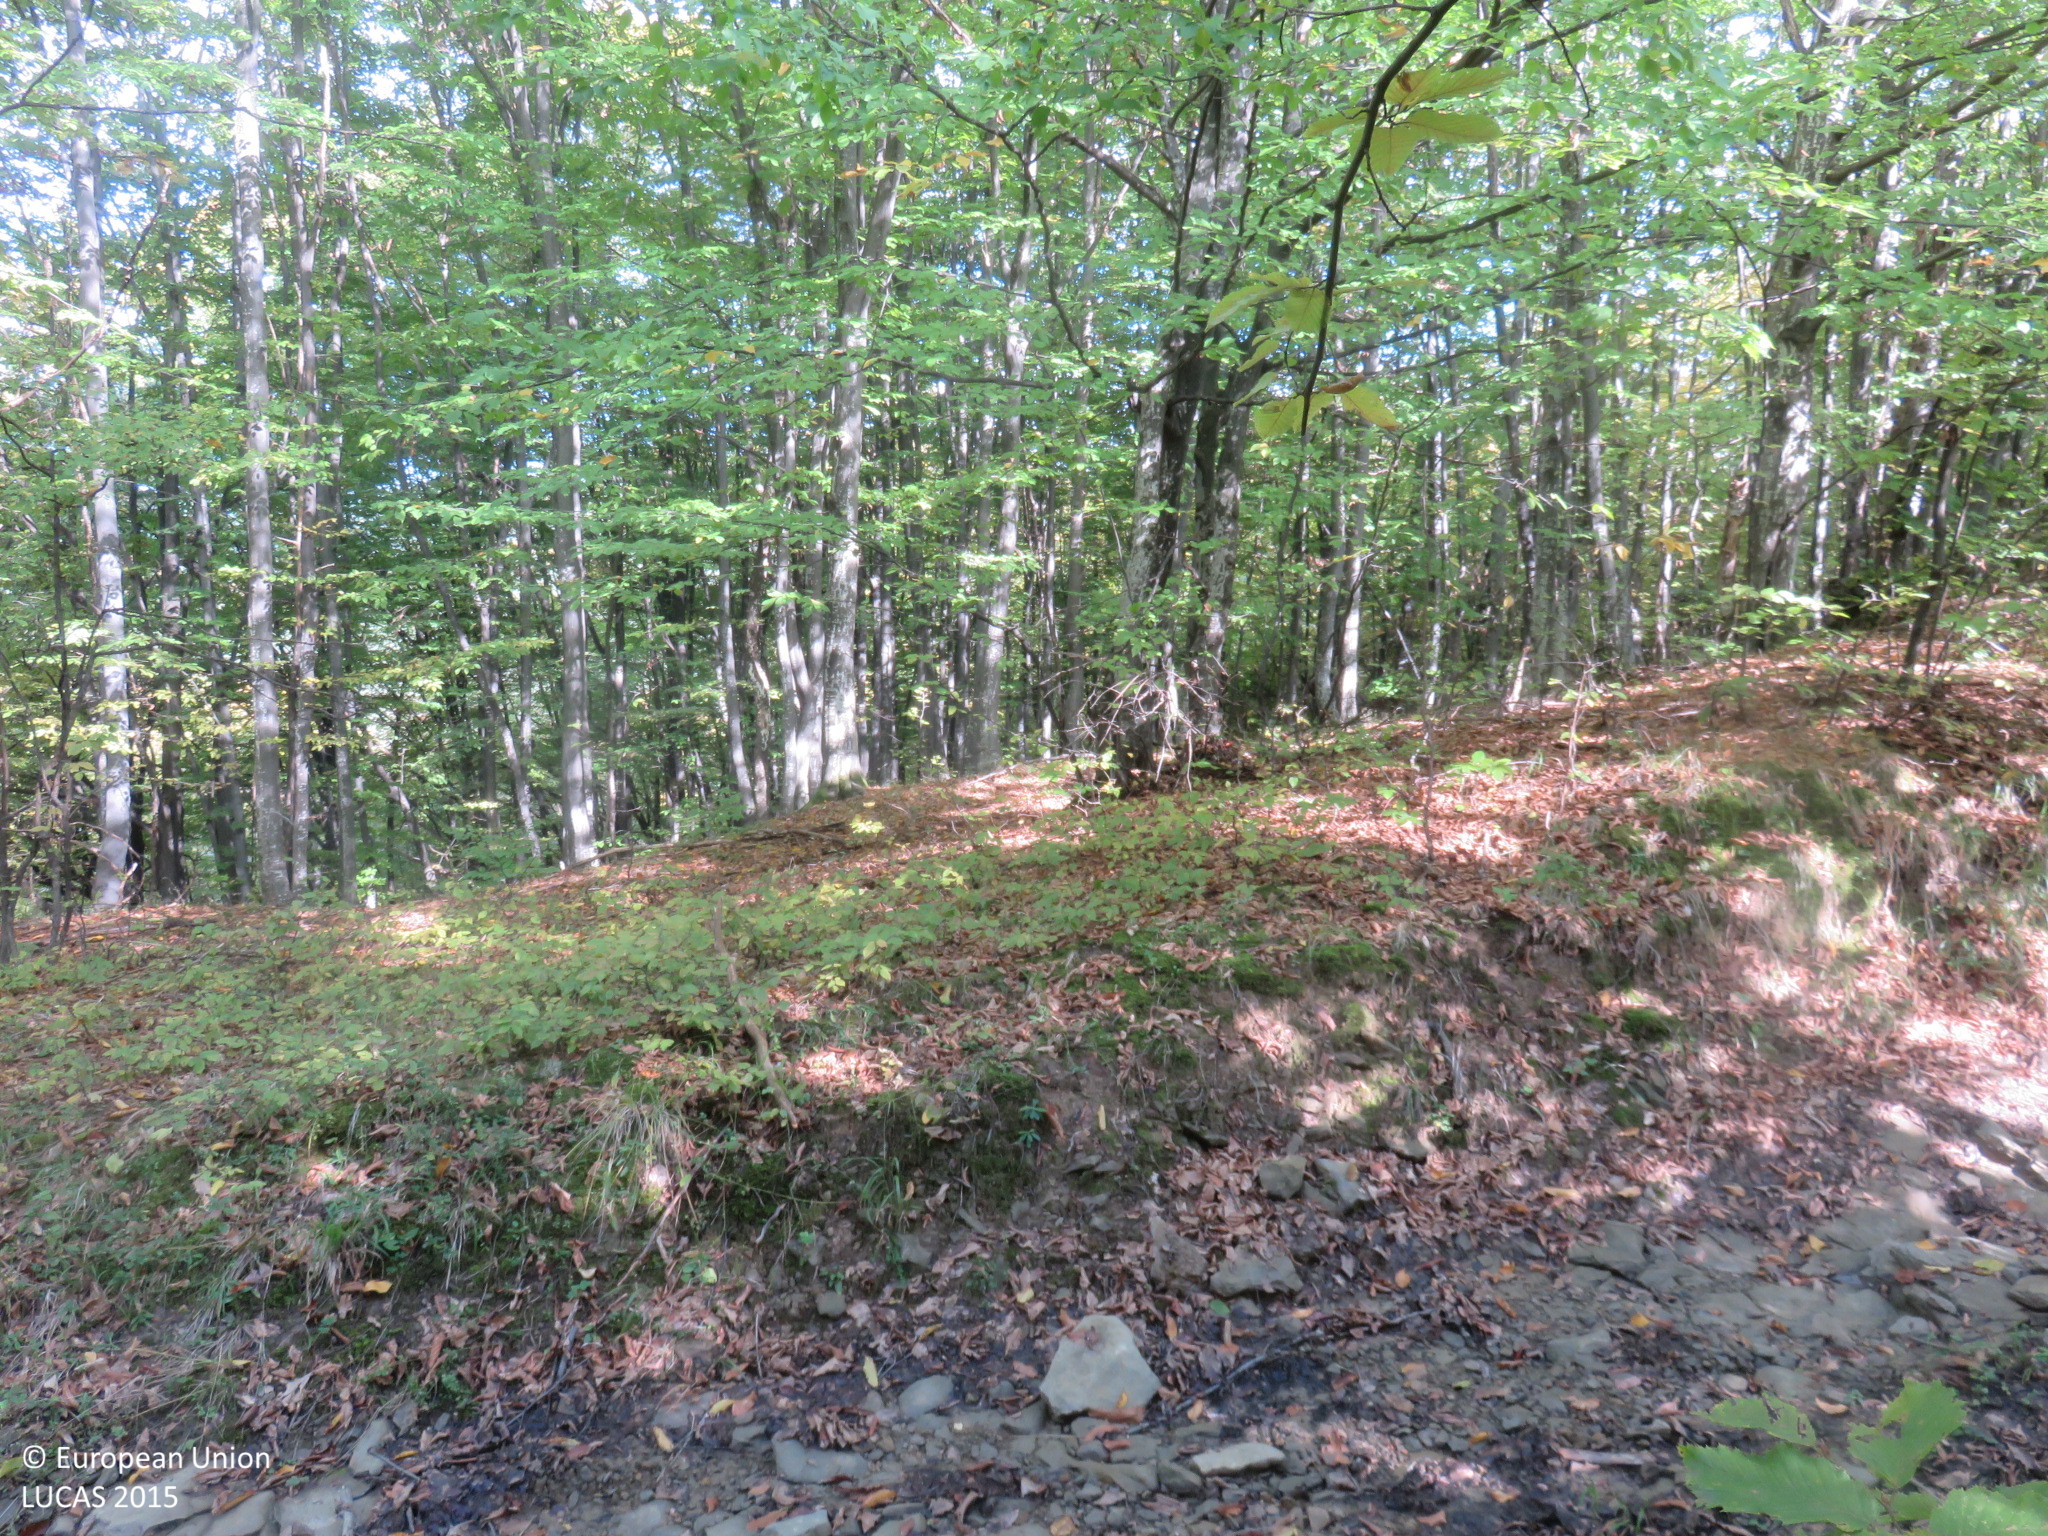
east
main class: Woodland
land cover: Broadleaved woodland
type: beech forest
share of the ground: > 75 %
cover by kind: broadleaved forest trees 95 %, shrubs 5 %
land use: Forestry
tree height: > 5 m
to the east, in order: Broadleaved woodland; Tracks; Broadleaved woodland
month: October
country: BG
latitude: 42.7855
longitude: 24.9393
